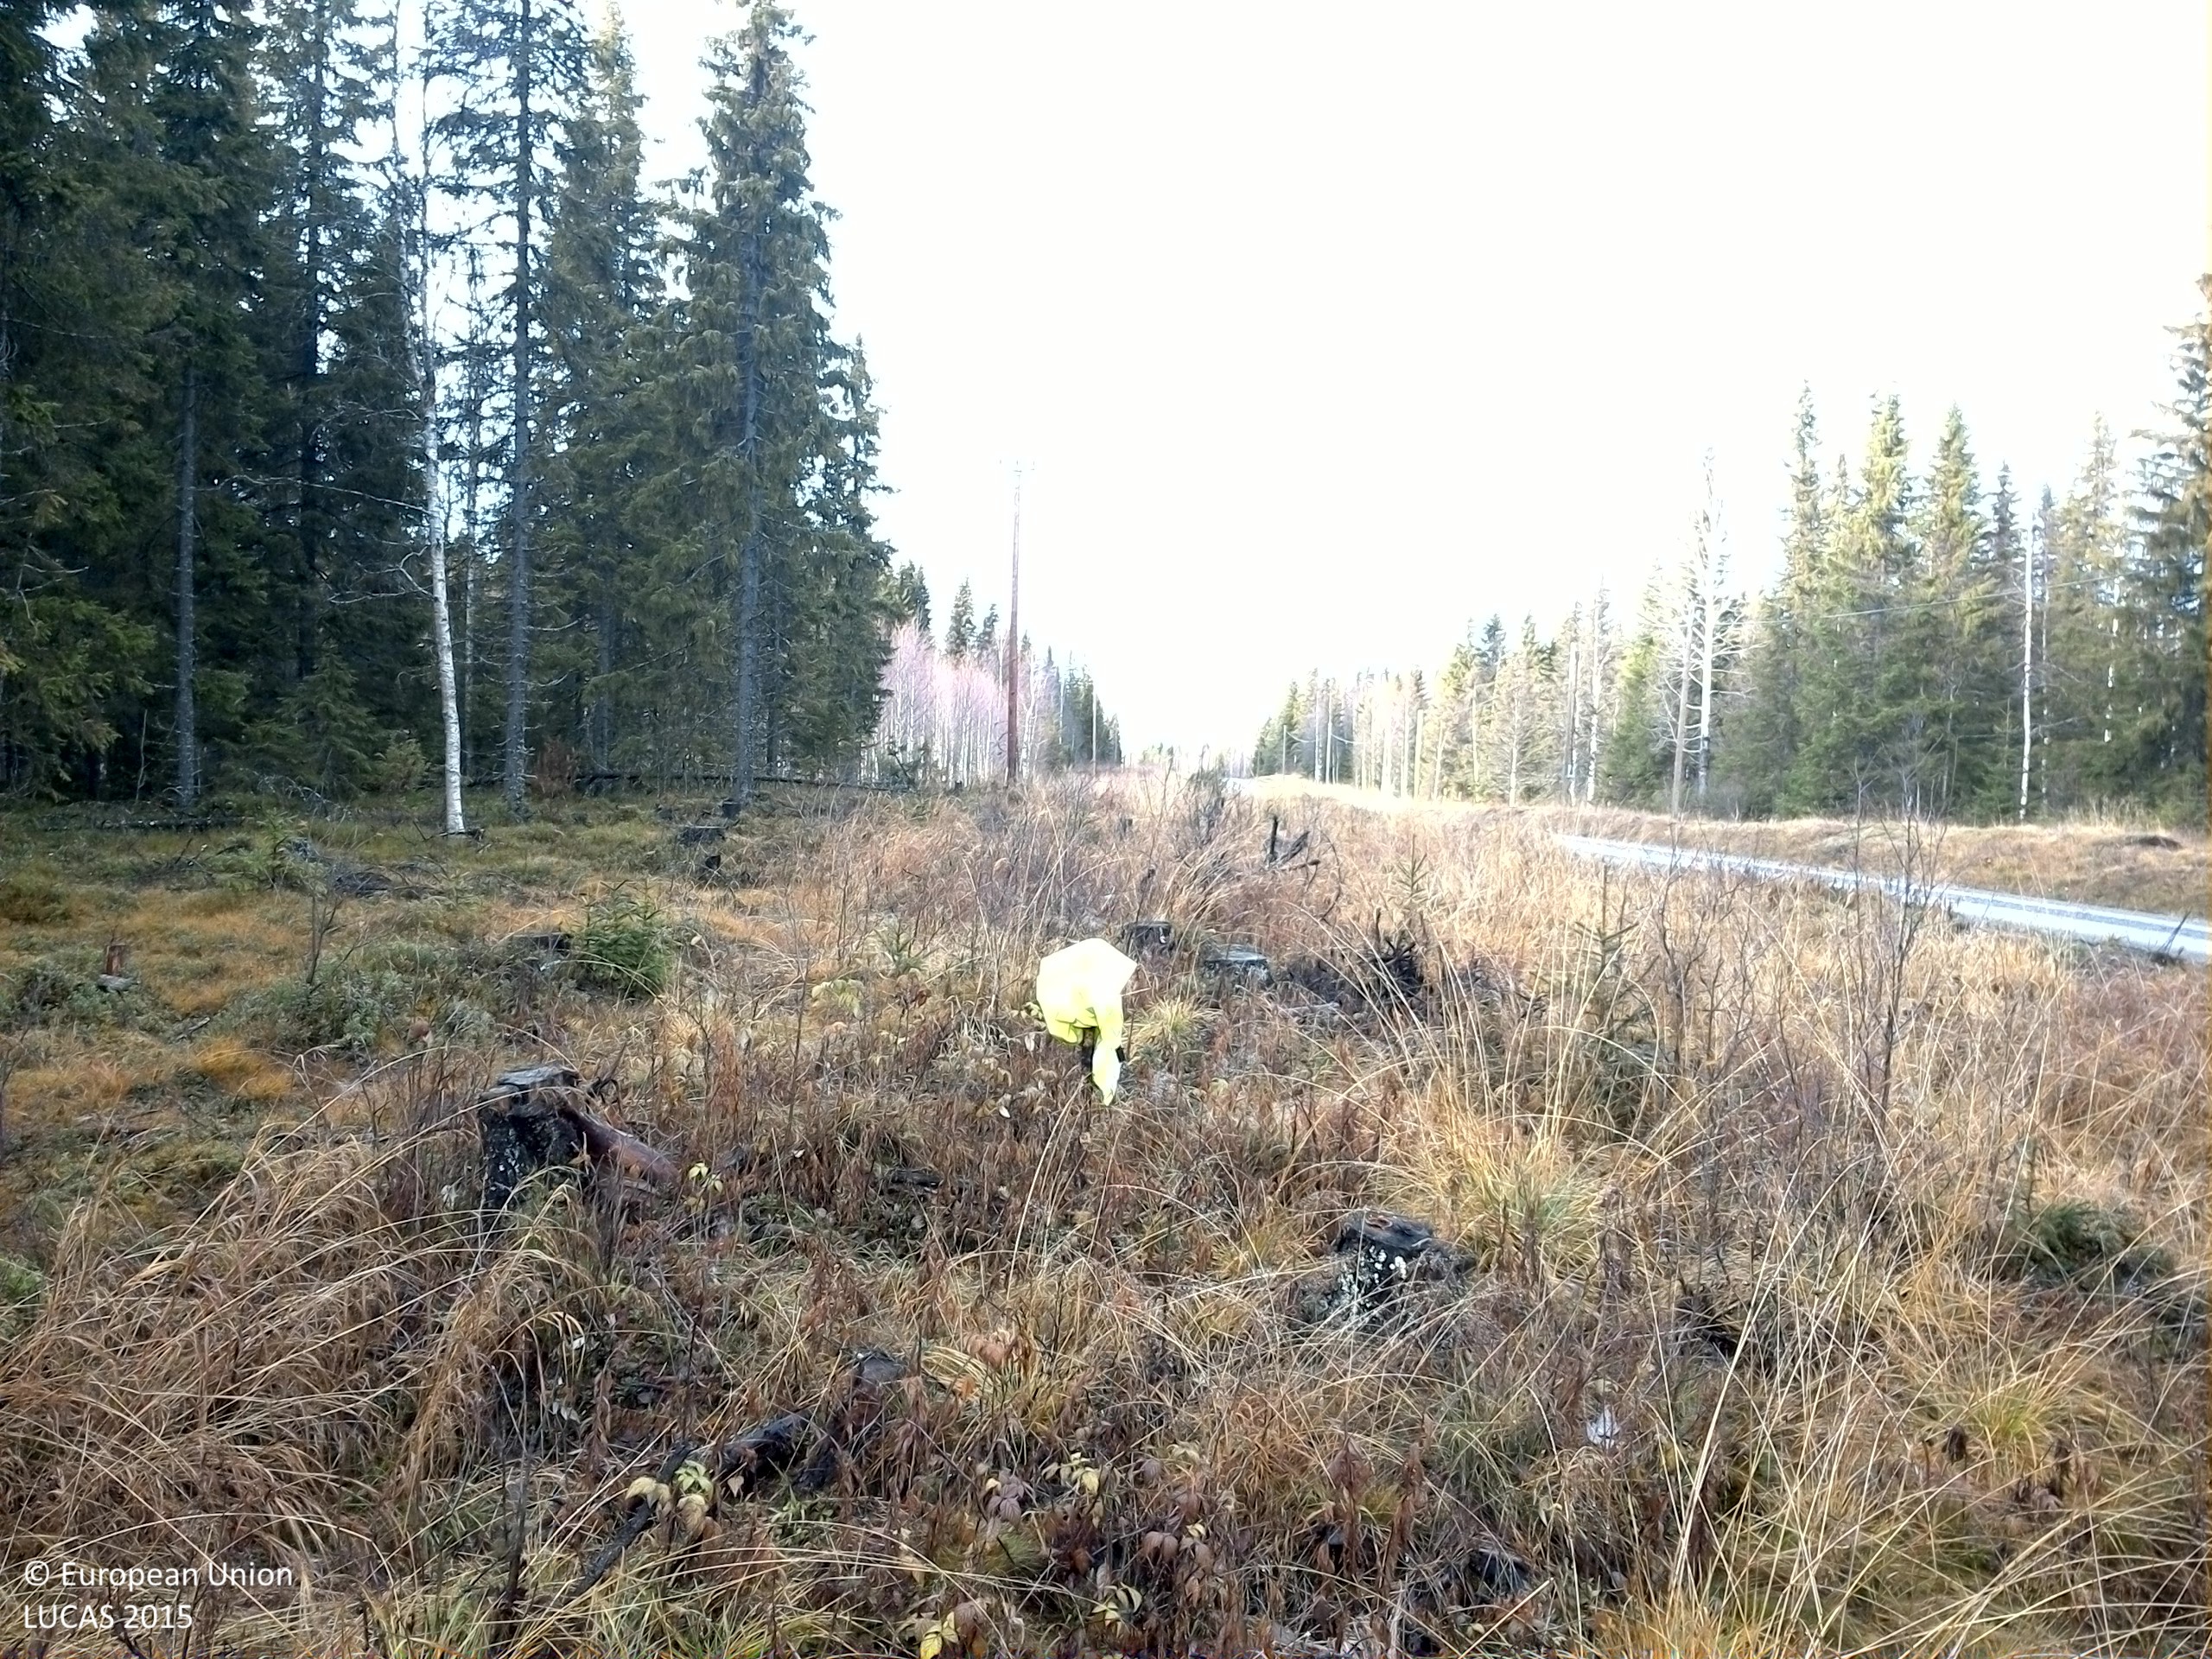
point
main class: Woodland
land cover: Broadleaved woodland
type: boreal forest
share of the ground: > 75 %
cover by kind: herbaceous plants 80 %, broadleaved forest trees 10 %, unconsolidated bare surface 10 %
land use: Forestry
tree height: < 5 m
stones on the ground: 10 - 25 %
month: October
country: SE
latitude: 63.7458
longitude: 15.3842
